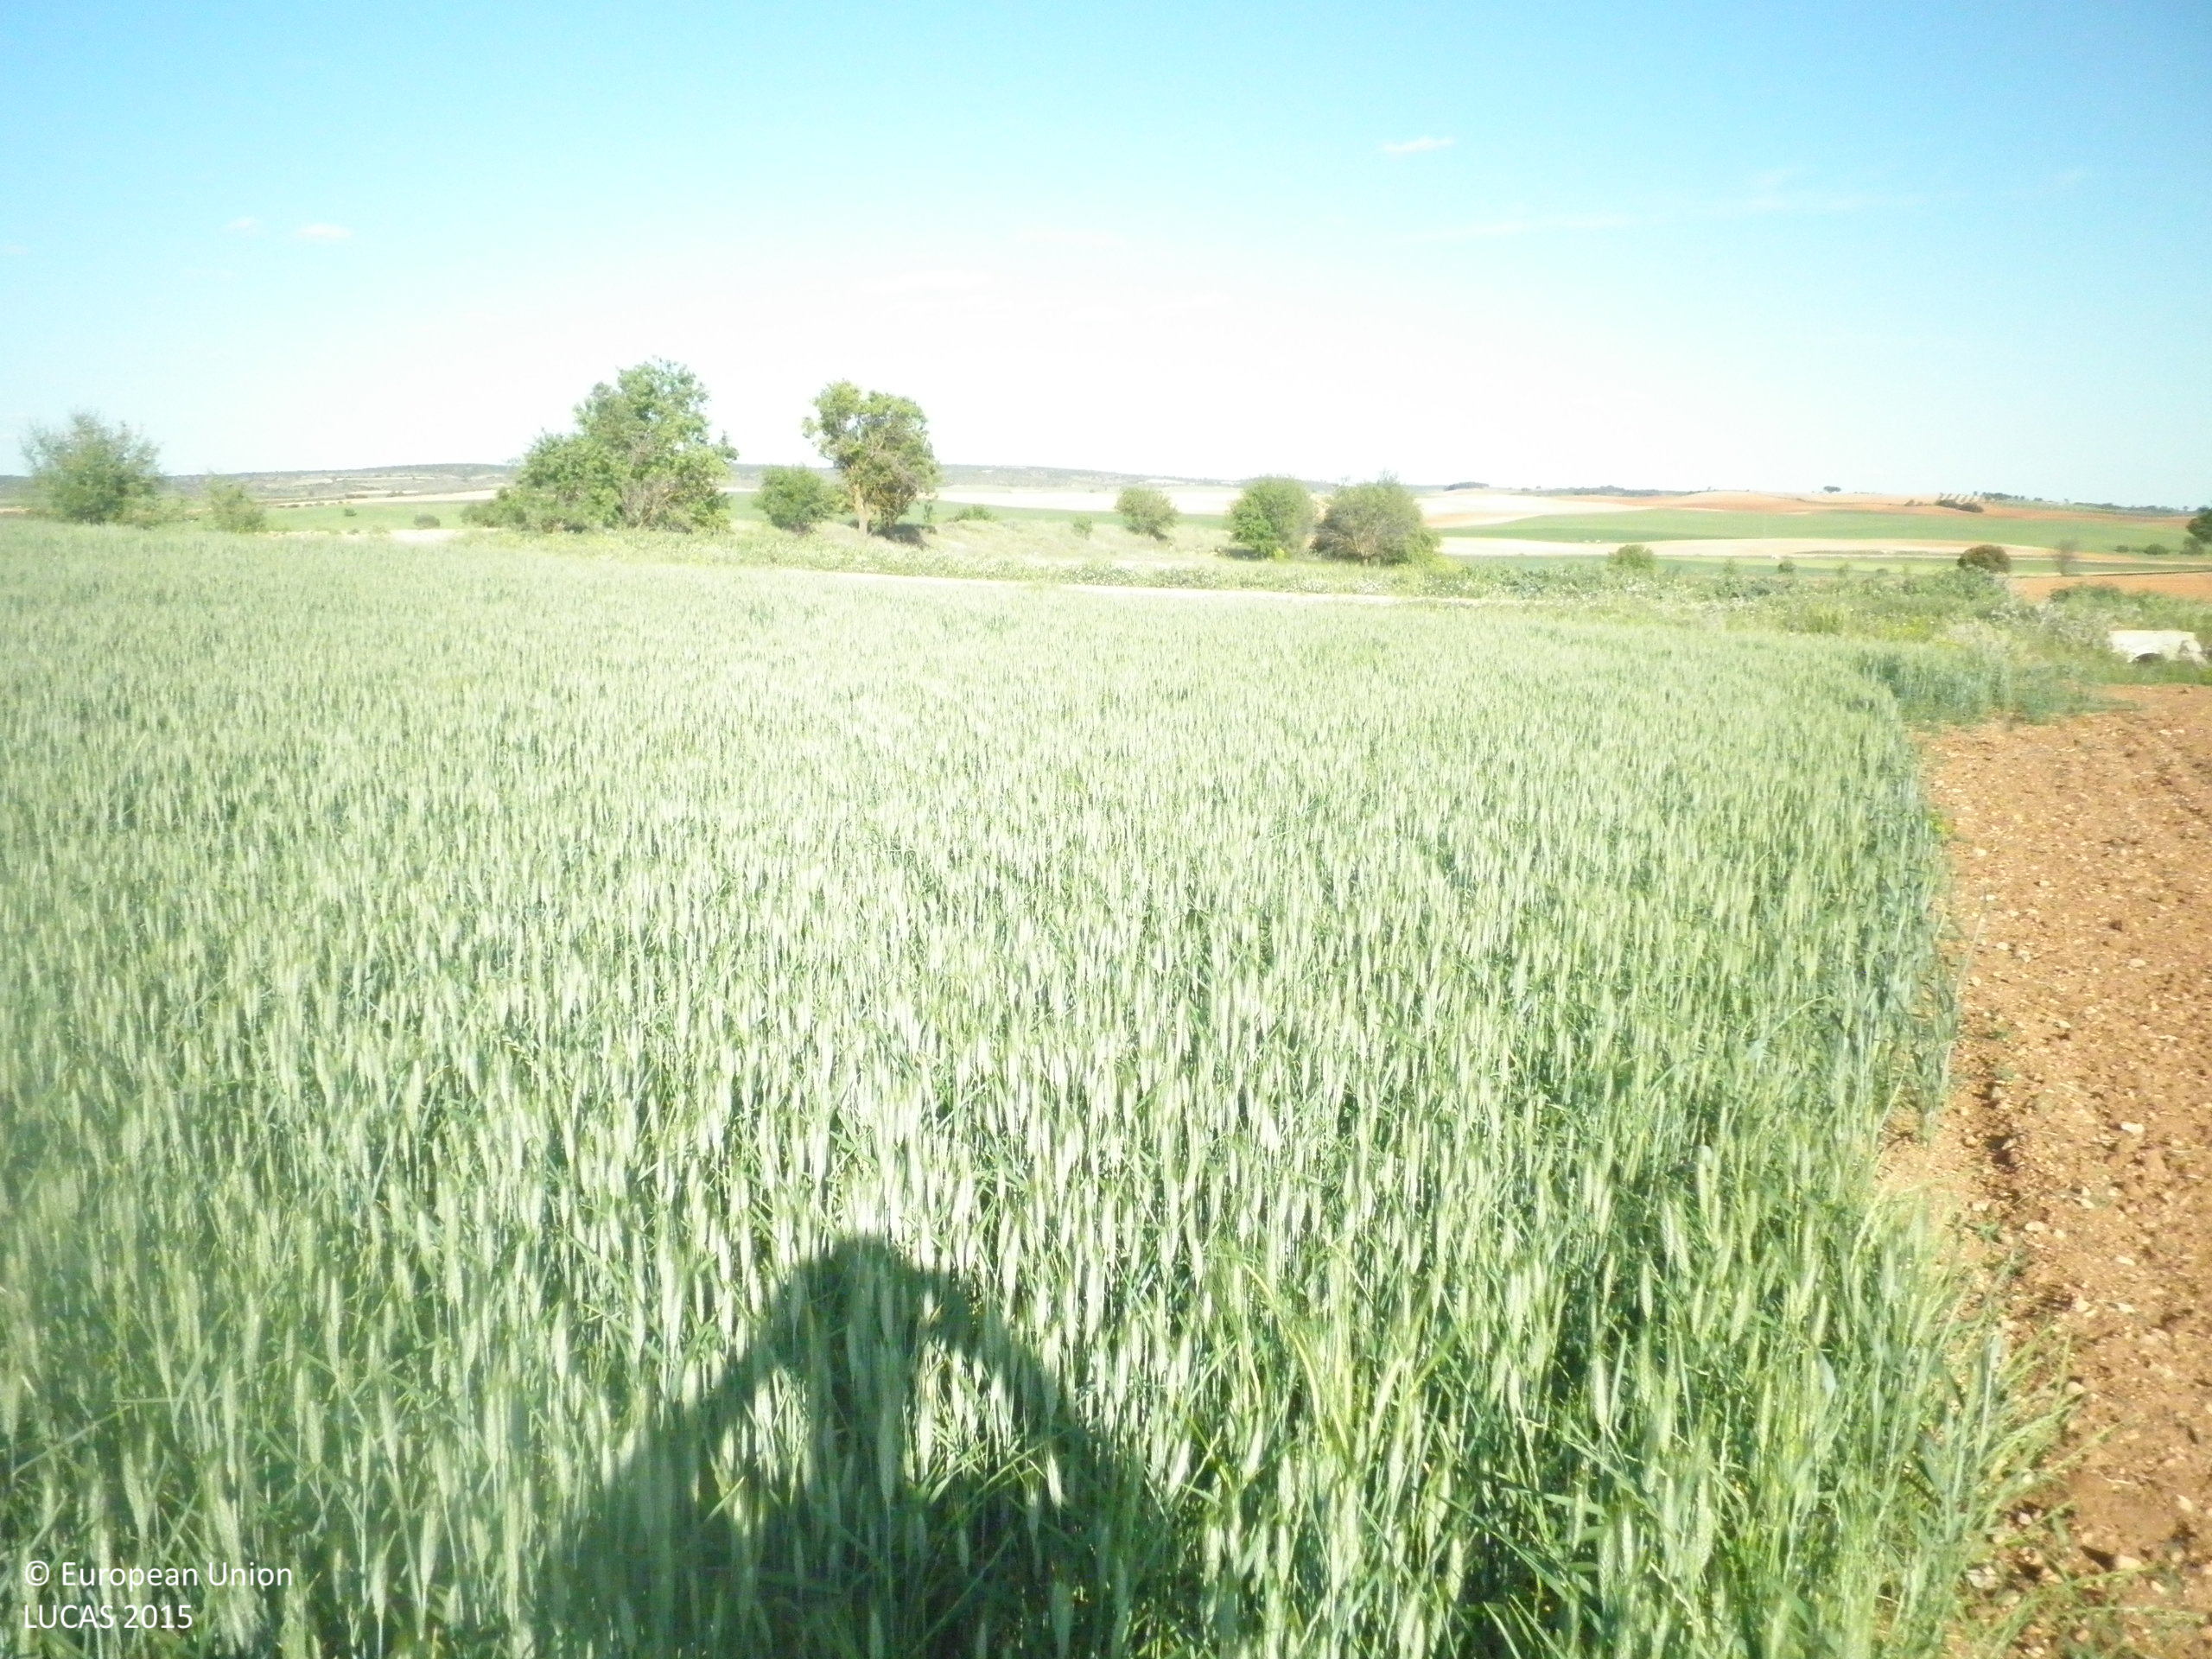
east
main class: Cropland
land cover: Rye
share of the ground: > 75 %
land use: Agriculture (excluding fallow land and kitchen gardens)
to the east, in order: Rye; Grass margins; Tracks; Grass margins; Other bare soil; Grassland without tree/shrub cover; Groves; Other bare soil
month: May
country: ES
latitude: 39.6864
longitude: -2.7616
